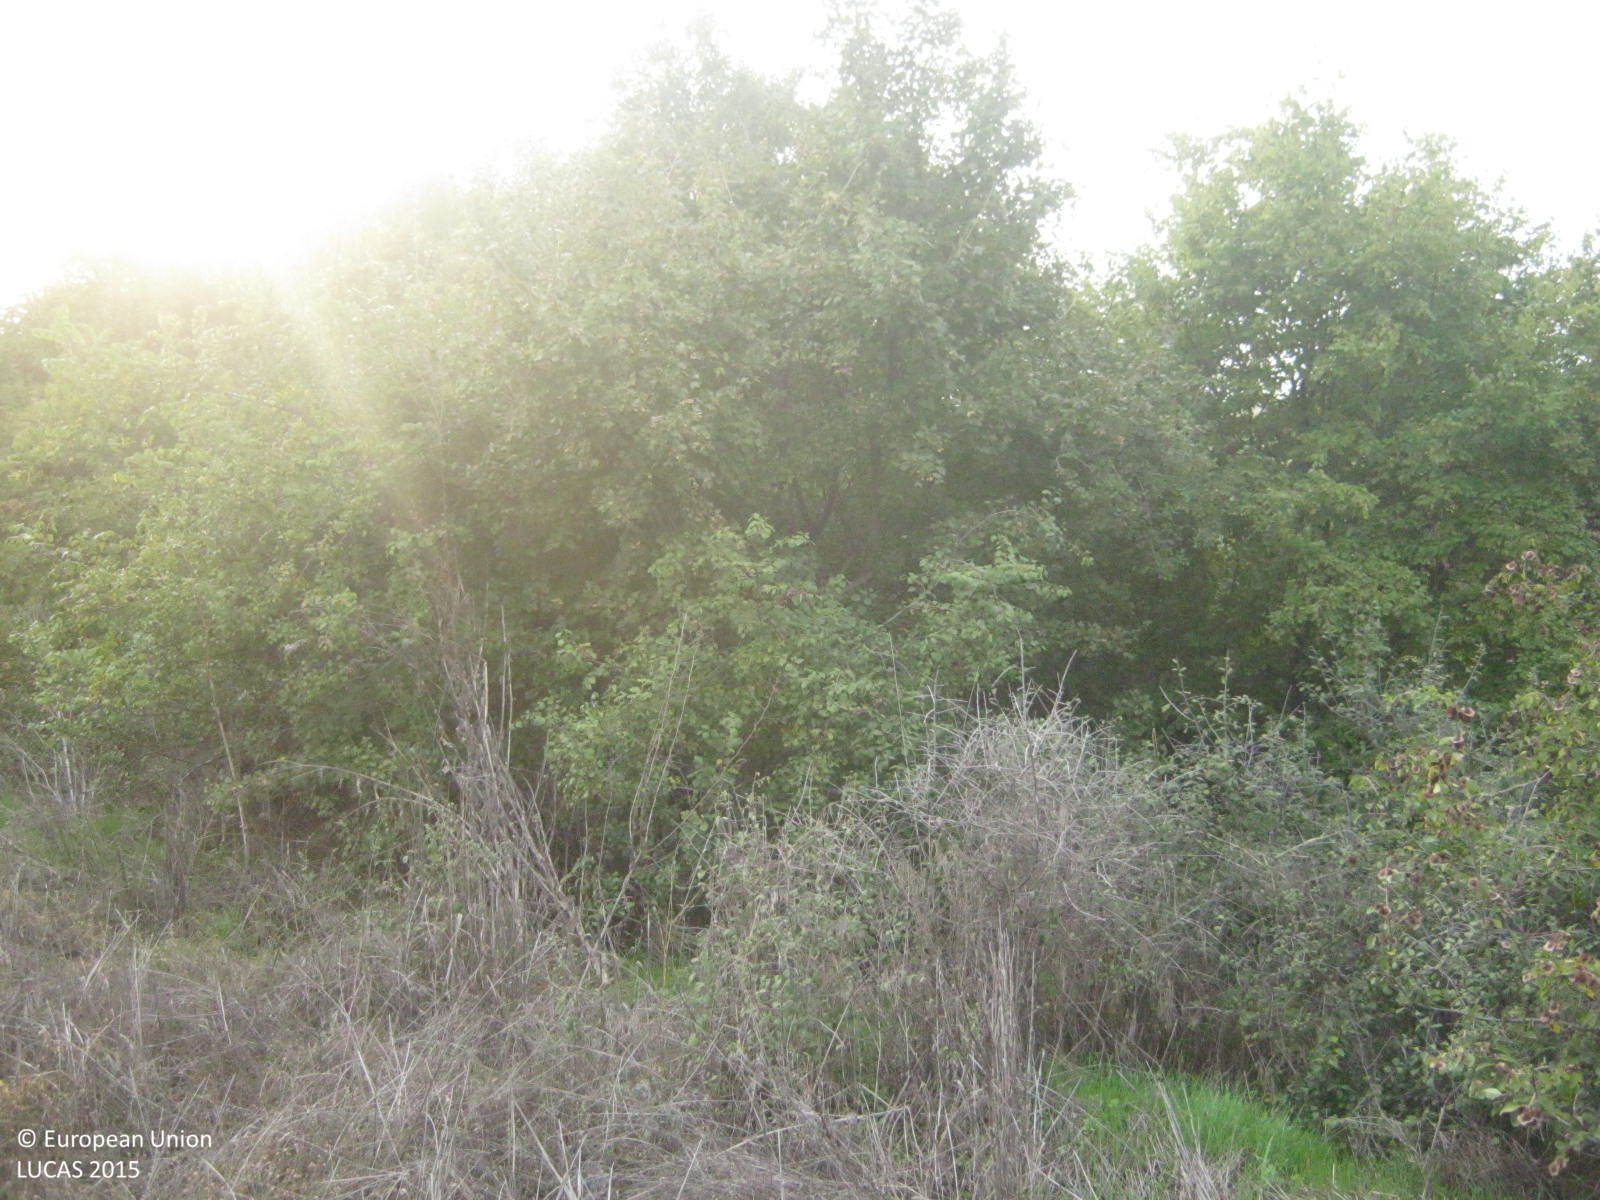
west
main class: Woodland
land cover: Broadleaved woodland
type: thermophilous deciduous forest
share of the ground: > 75 %
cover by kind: broadleaved forest trees 75 %, shrubs 15 %, herbaceous plants 10 %
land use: Semi-natural and natural areas not in use
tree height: > 5 m
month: October
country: GR
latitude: 40.9746
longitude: 22.9768
